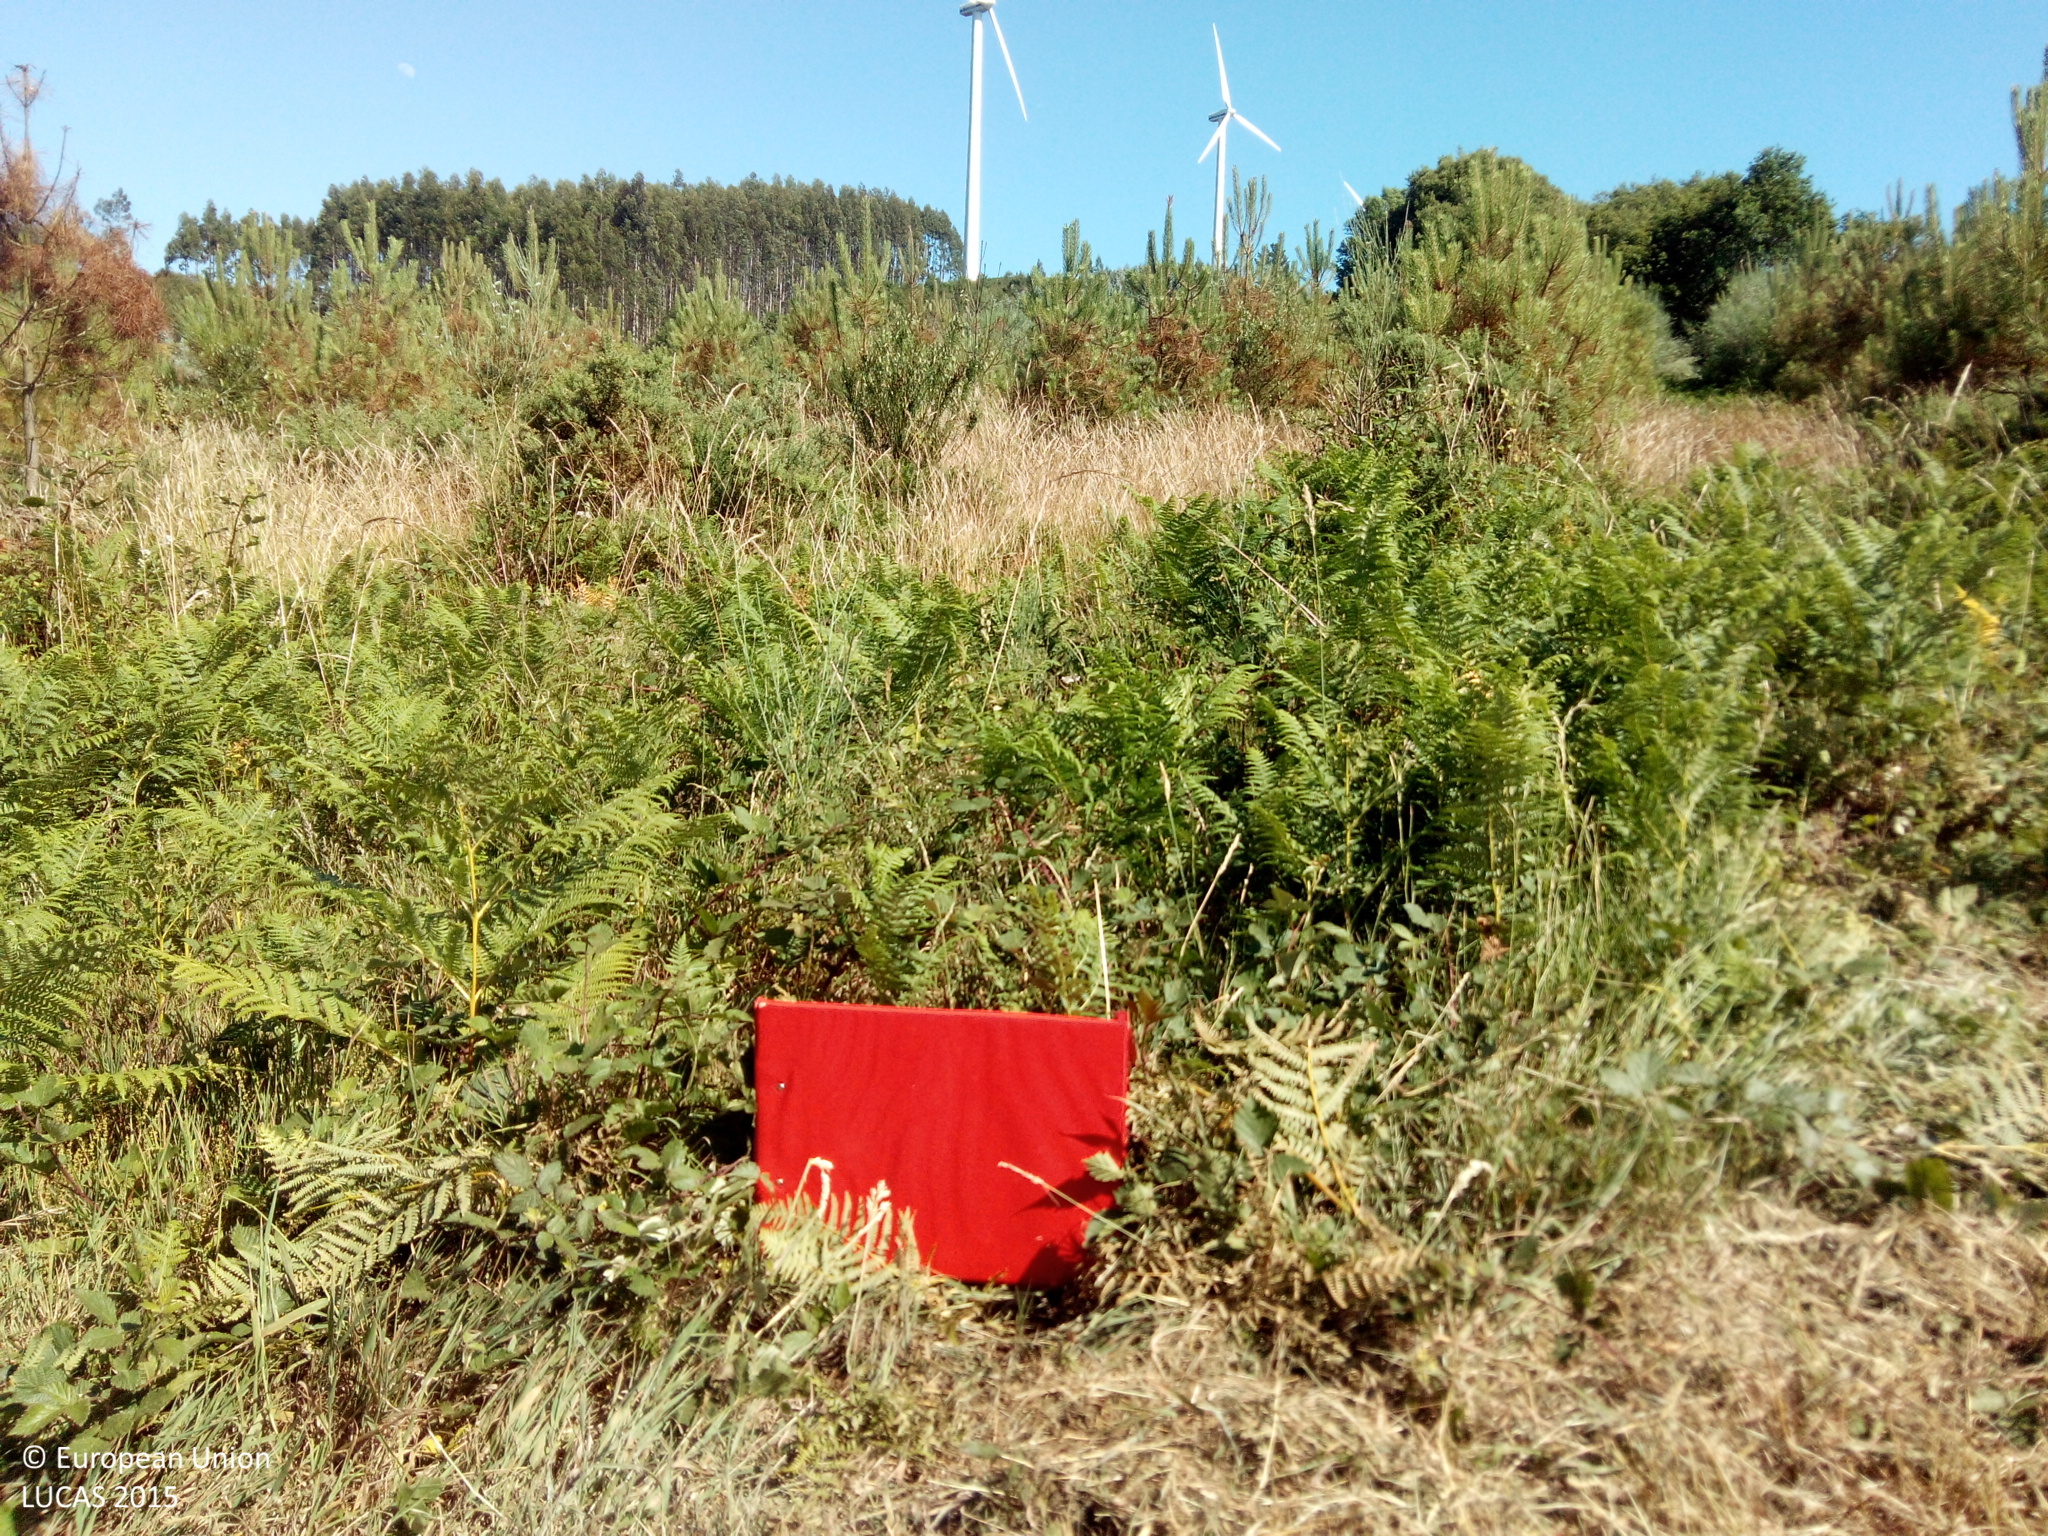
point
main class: Woodland
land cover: Pine dominated coniferous woodland
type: hemiboreal forest and nemoral coniferous forest and mixed broadleaved-coniferous forest
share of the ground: 25 - 50 %
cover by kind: coniferous forest trees 50 %, shrubs 30 %, herbaceous plants 20 %
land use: Forestry
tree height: < 5 m
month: June
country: ES
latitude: 42.9939
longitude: -8.0352
